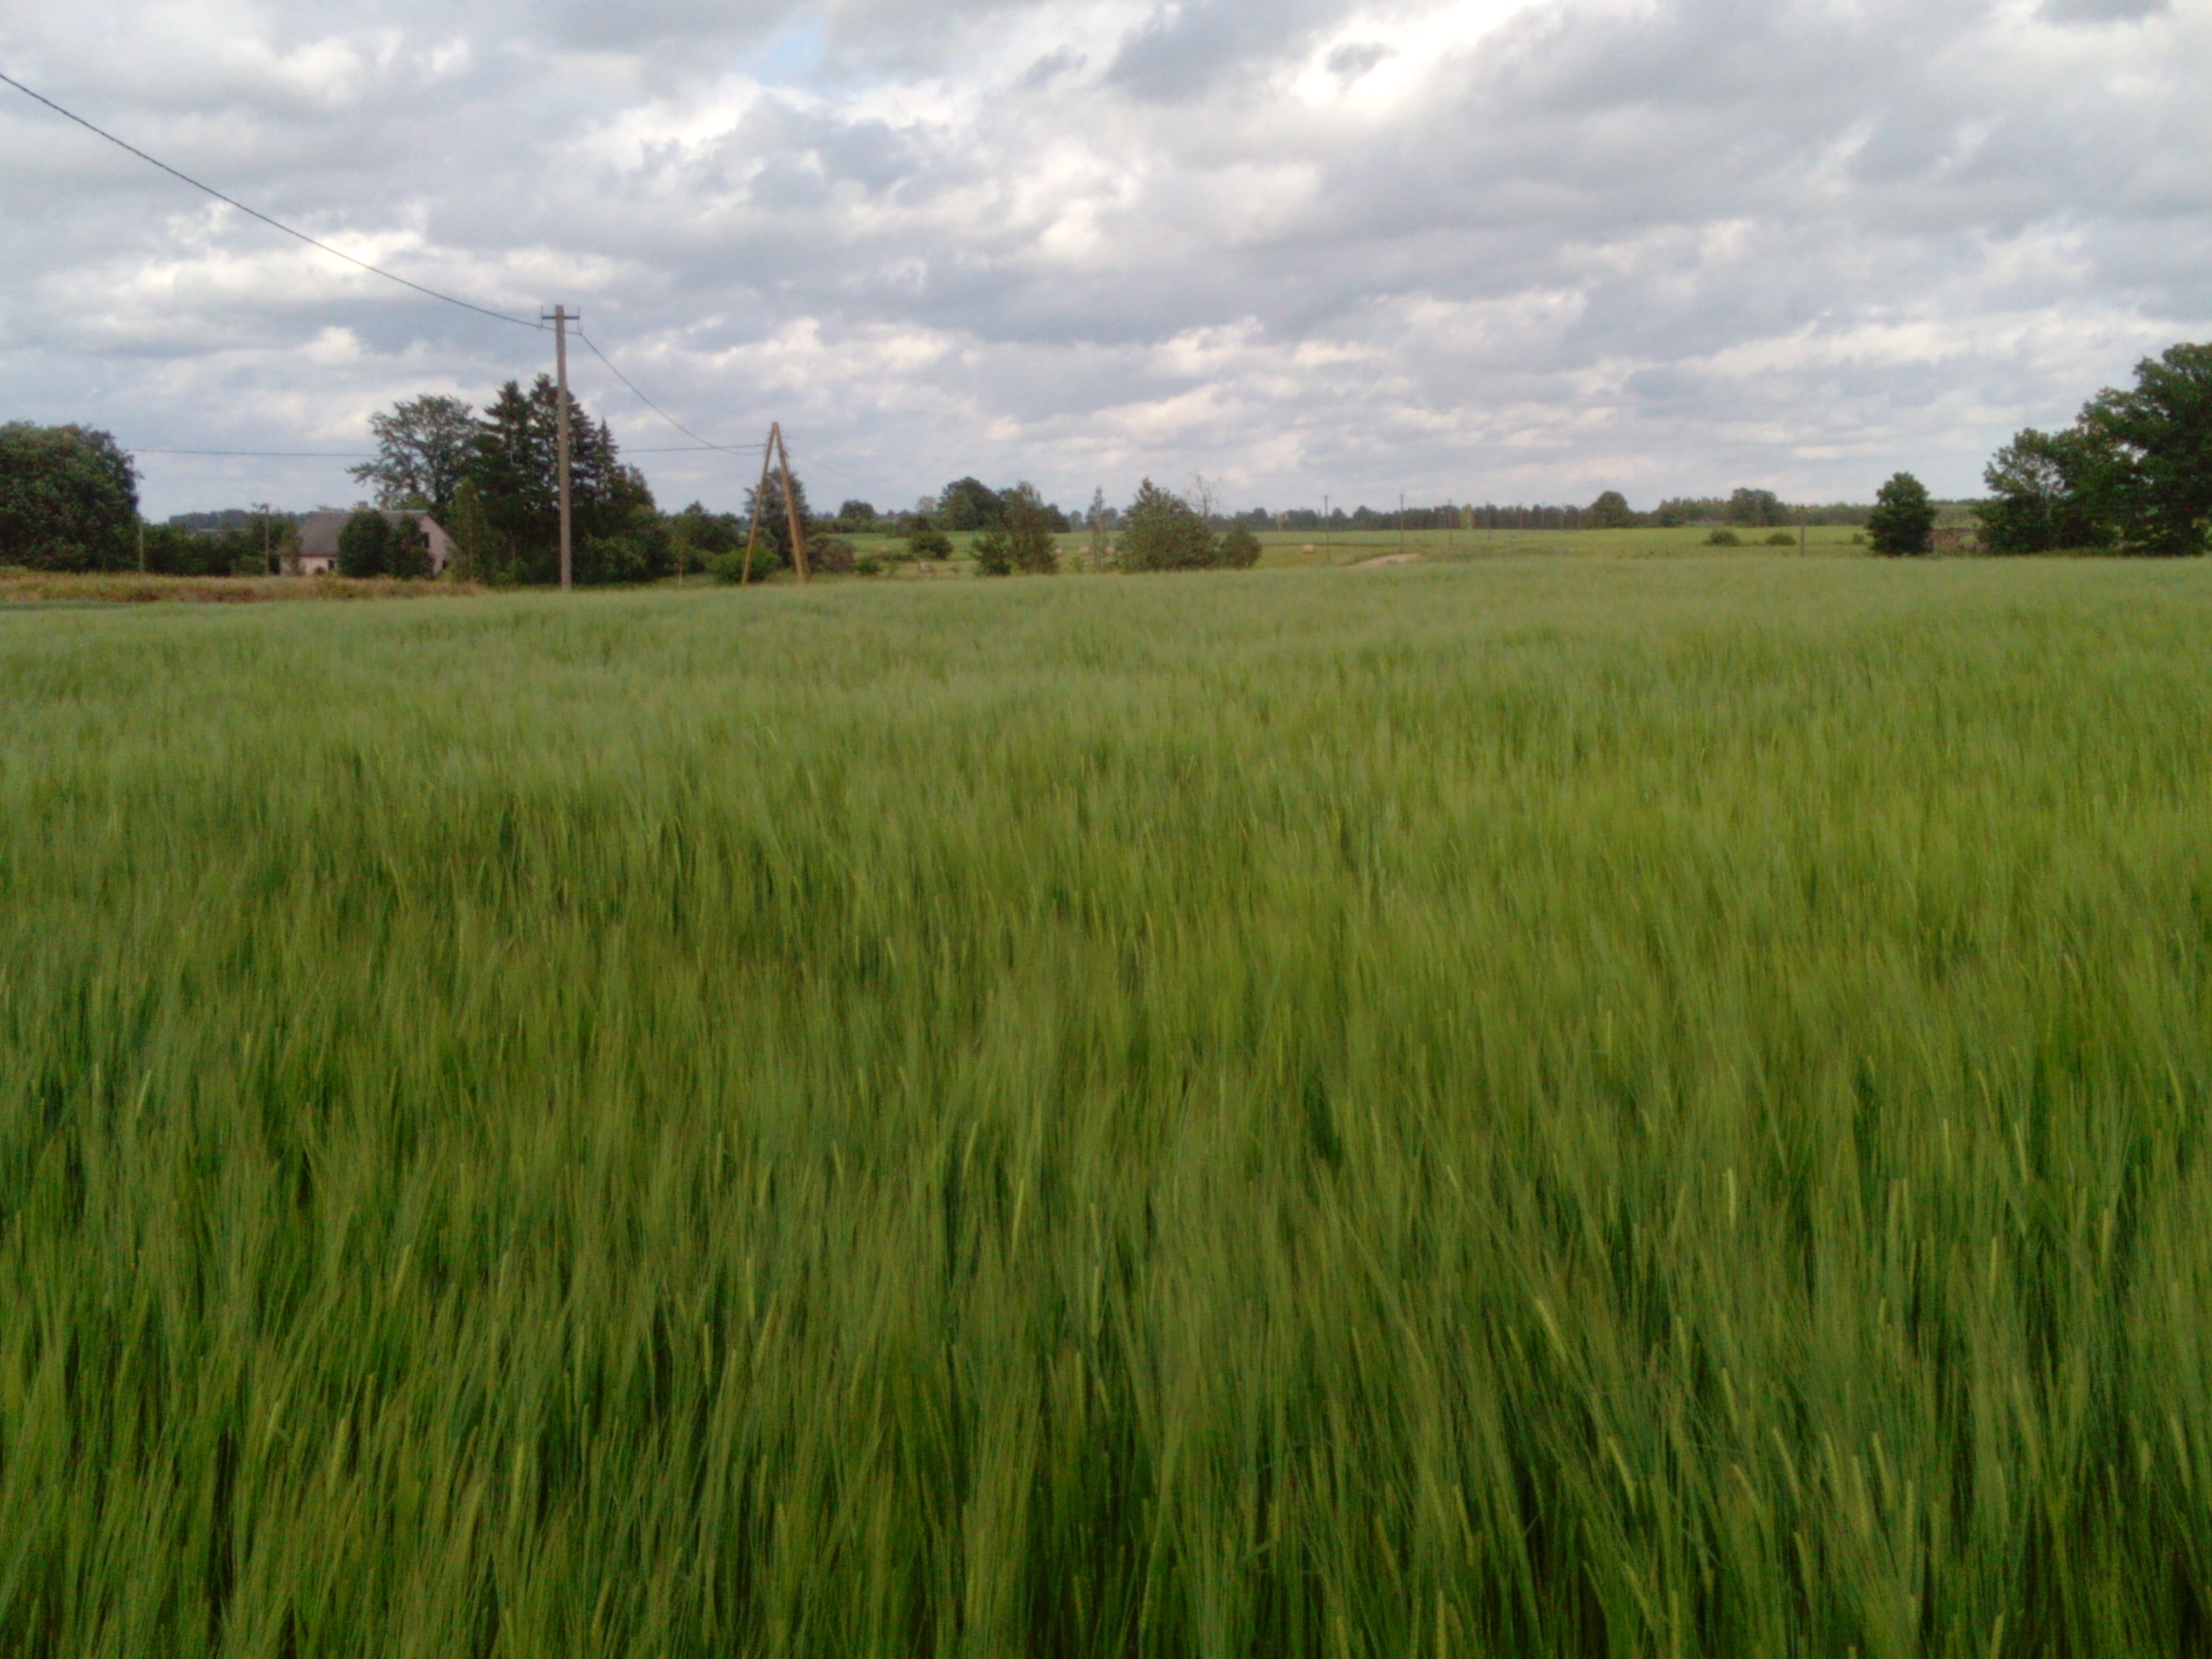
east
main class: Cropland
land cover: Barley
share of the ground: > 75 %
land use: Agriculture (excluding fallow land and kitchen gardens)
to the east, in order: Barley; Rye; Grassland without tree/shrub cover; Abandoned hedges; Ditches and canals; Grassland without tree/shrub cover; Electric lines; Common wheat; Shruby margins; Tracks; Shruby margins; Common wheat; Spontaneously vegetated surfaces
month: July
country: LV
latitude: 56.9820
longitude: 22.4447
